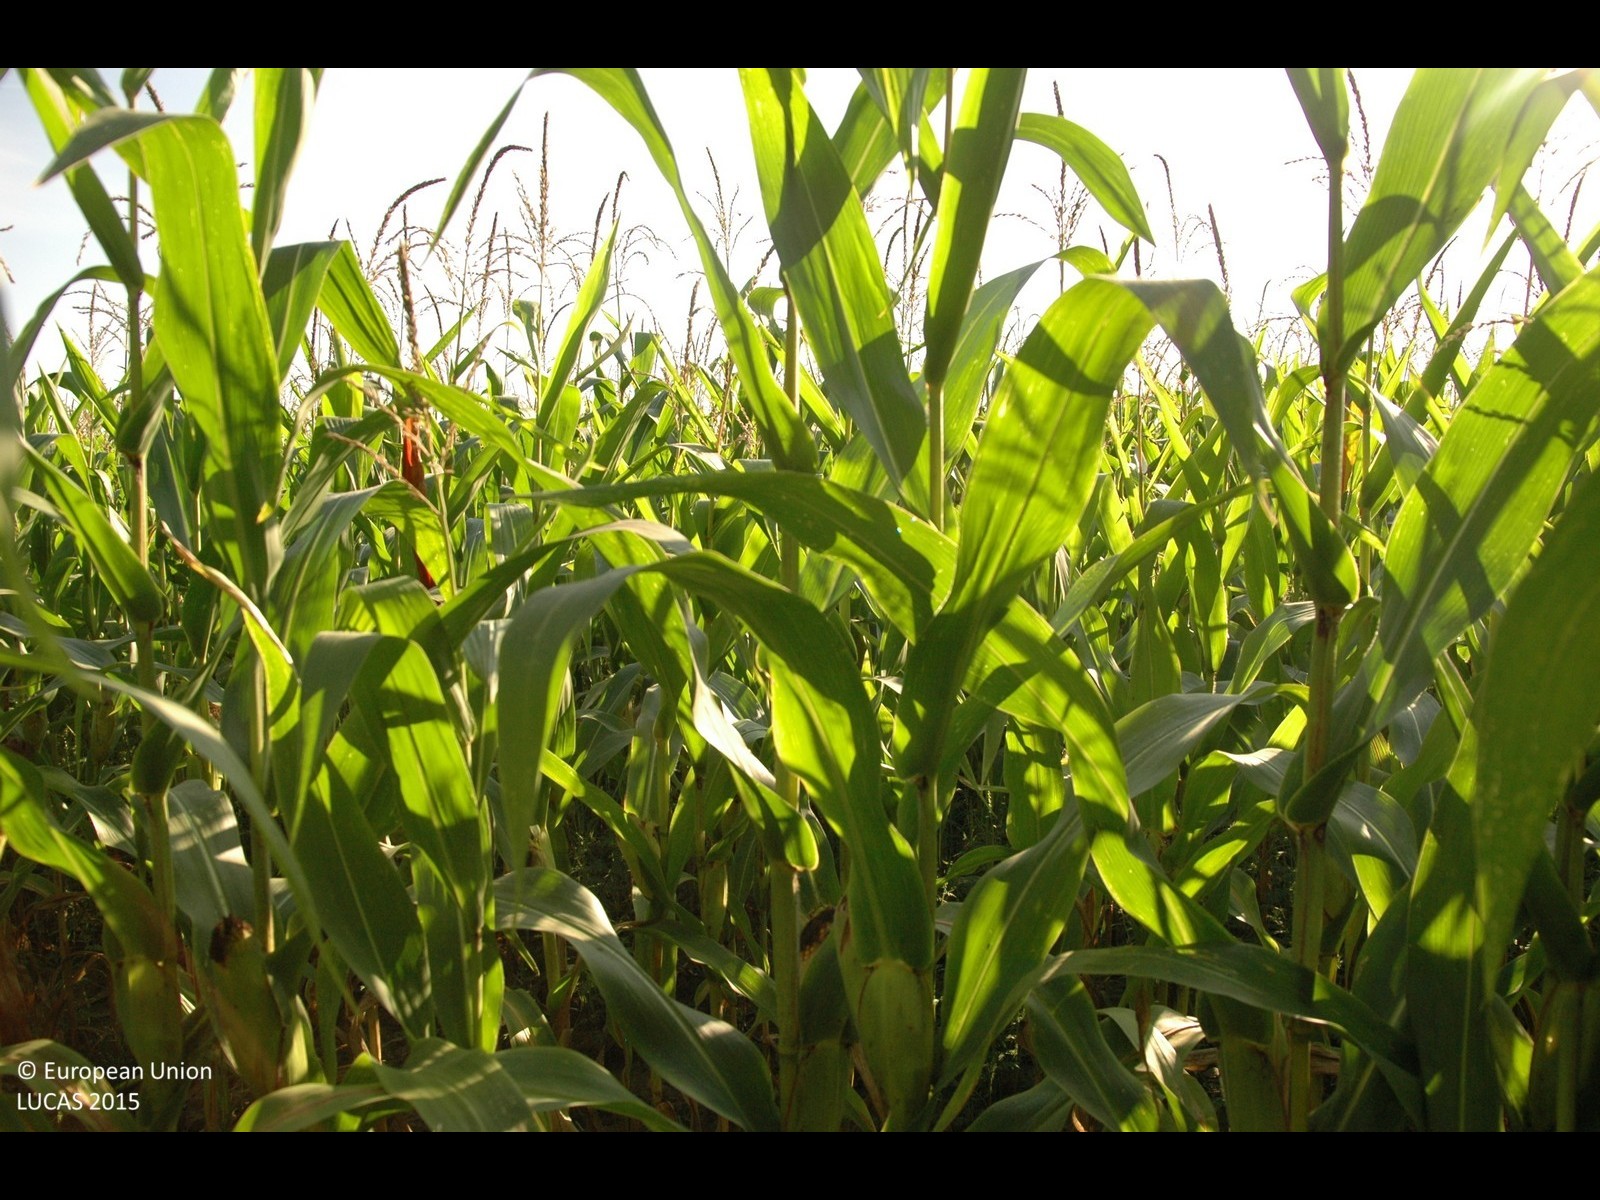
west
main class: Cropland
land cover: Maize
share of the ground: > 75 %
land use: Agriculture (excluding fallow land and kitchen gardens)
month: August
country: HR
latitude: 46.1087
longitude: 16.9231
